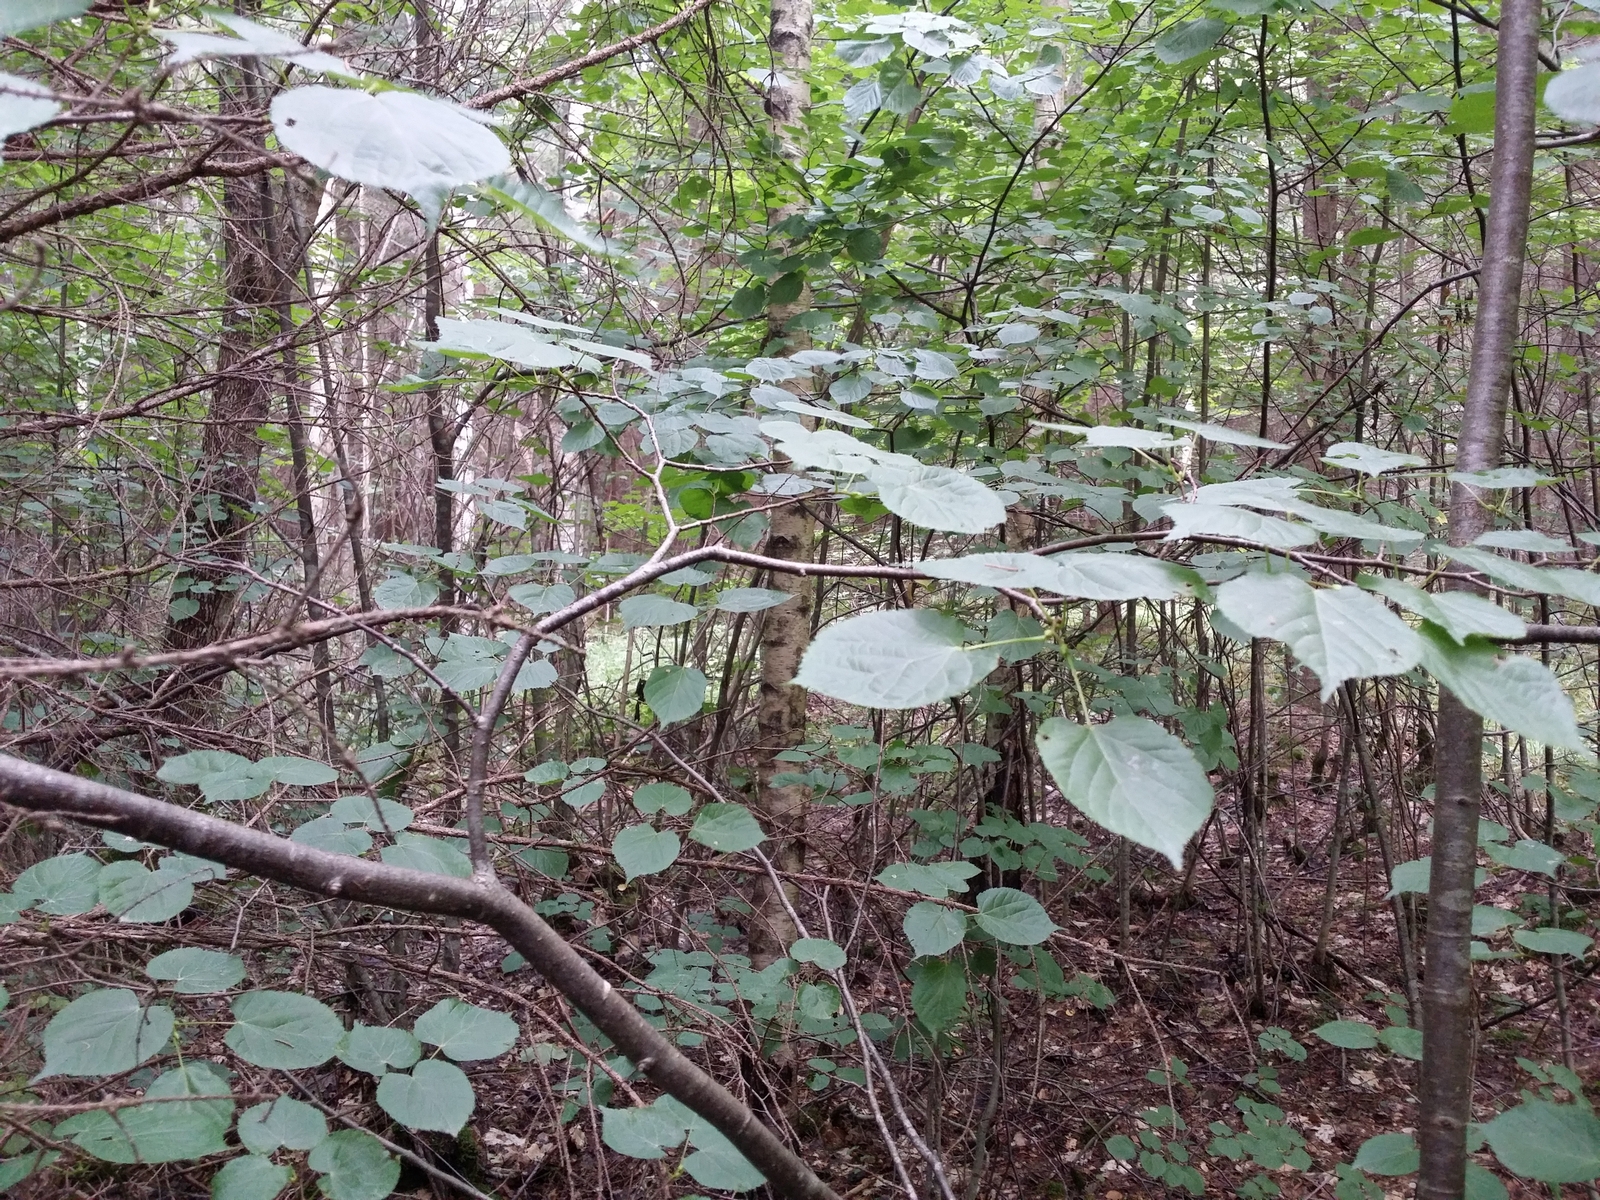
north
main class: Woodland
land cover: Spruce dominated mixed woodland
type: hemiboreal forest and nemoral coniferous forest and mixed broadleaved-coniferous forest
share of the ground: > 75 %
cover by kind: coniferous forest trees 50 %, broadleaved forest trees 35 %, shrubs 5 %, herbaceous plants 5 %, lichens and mosses 5 %
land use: Forestry
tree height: > 5 m
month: July
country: LV
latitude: 57.2687
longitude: 27.2983
